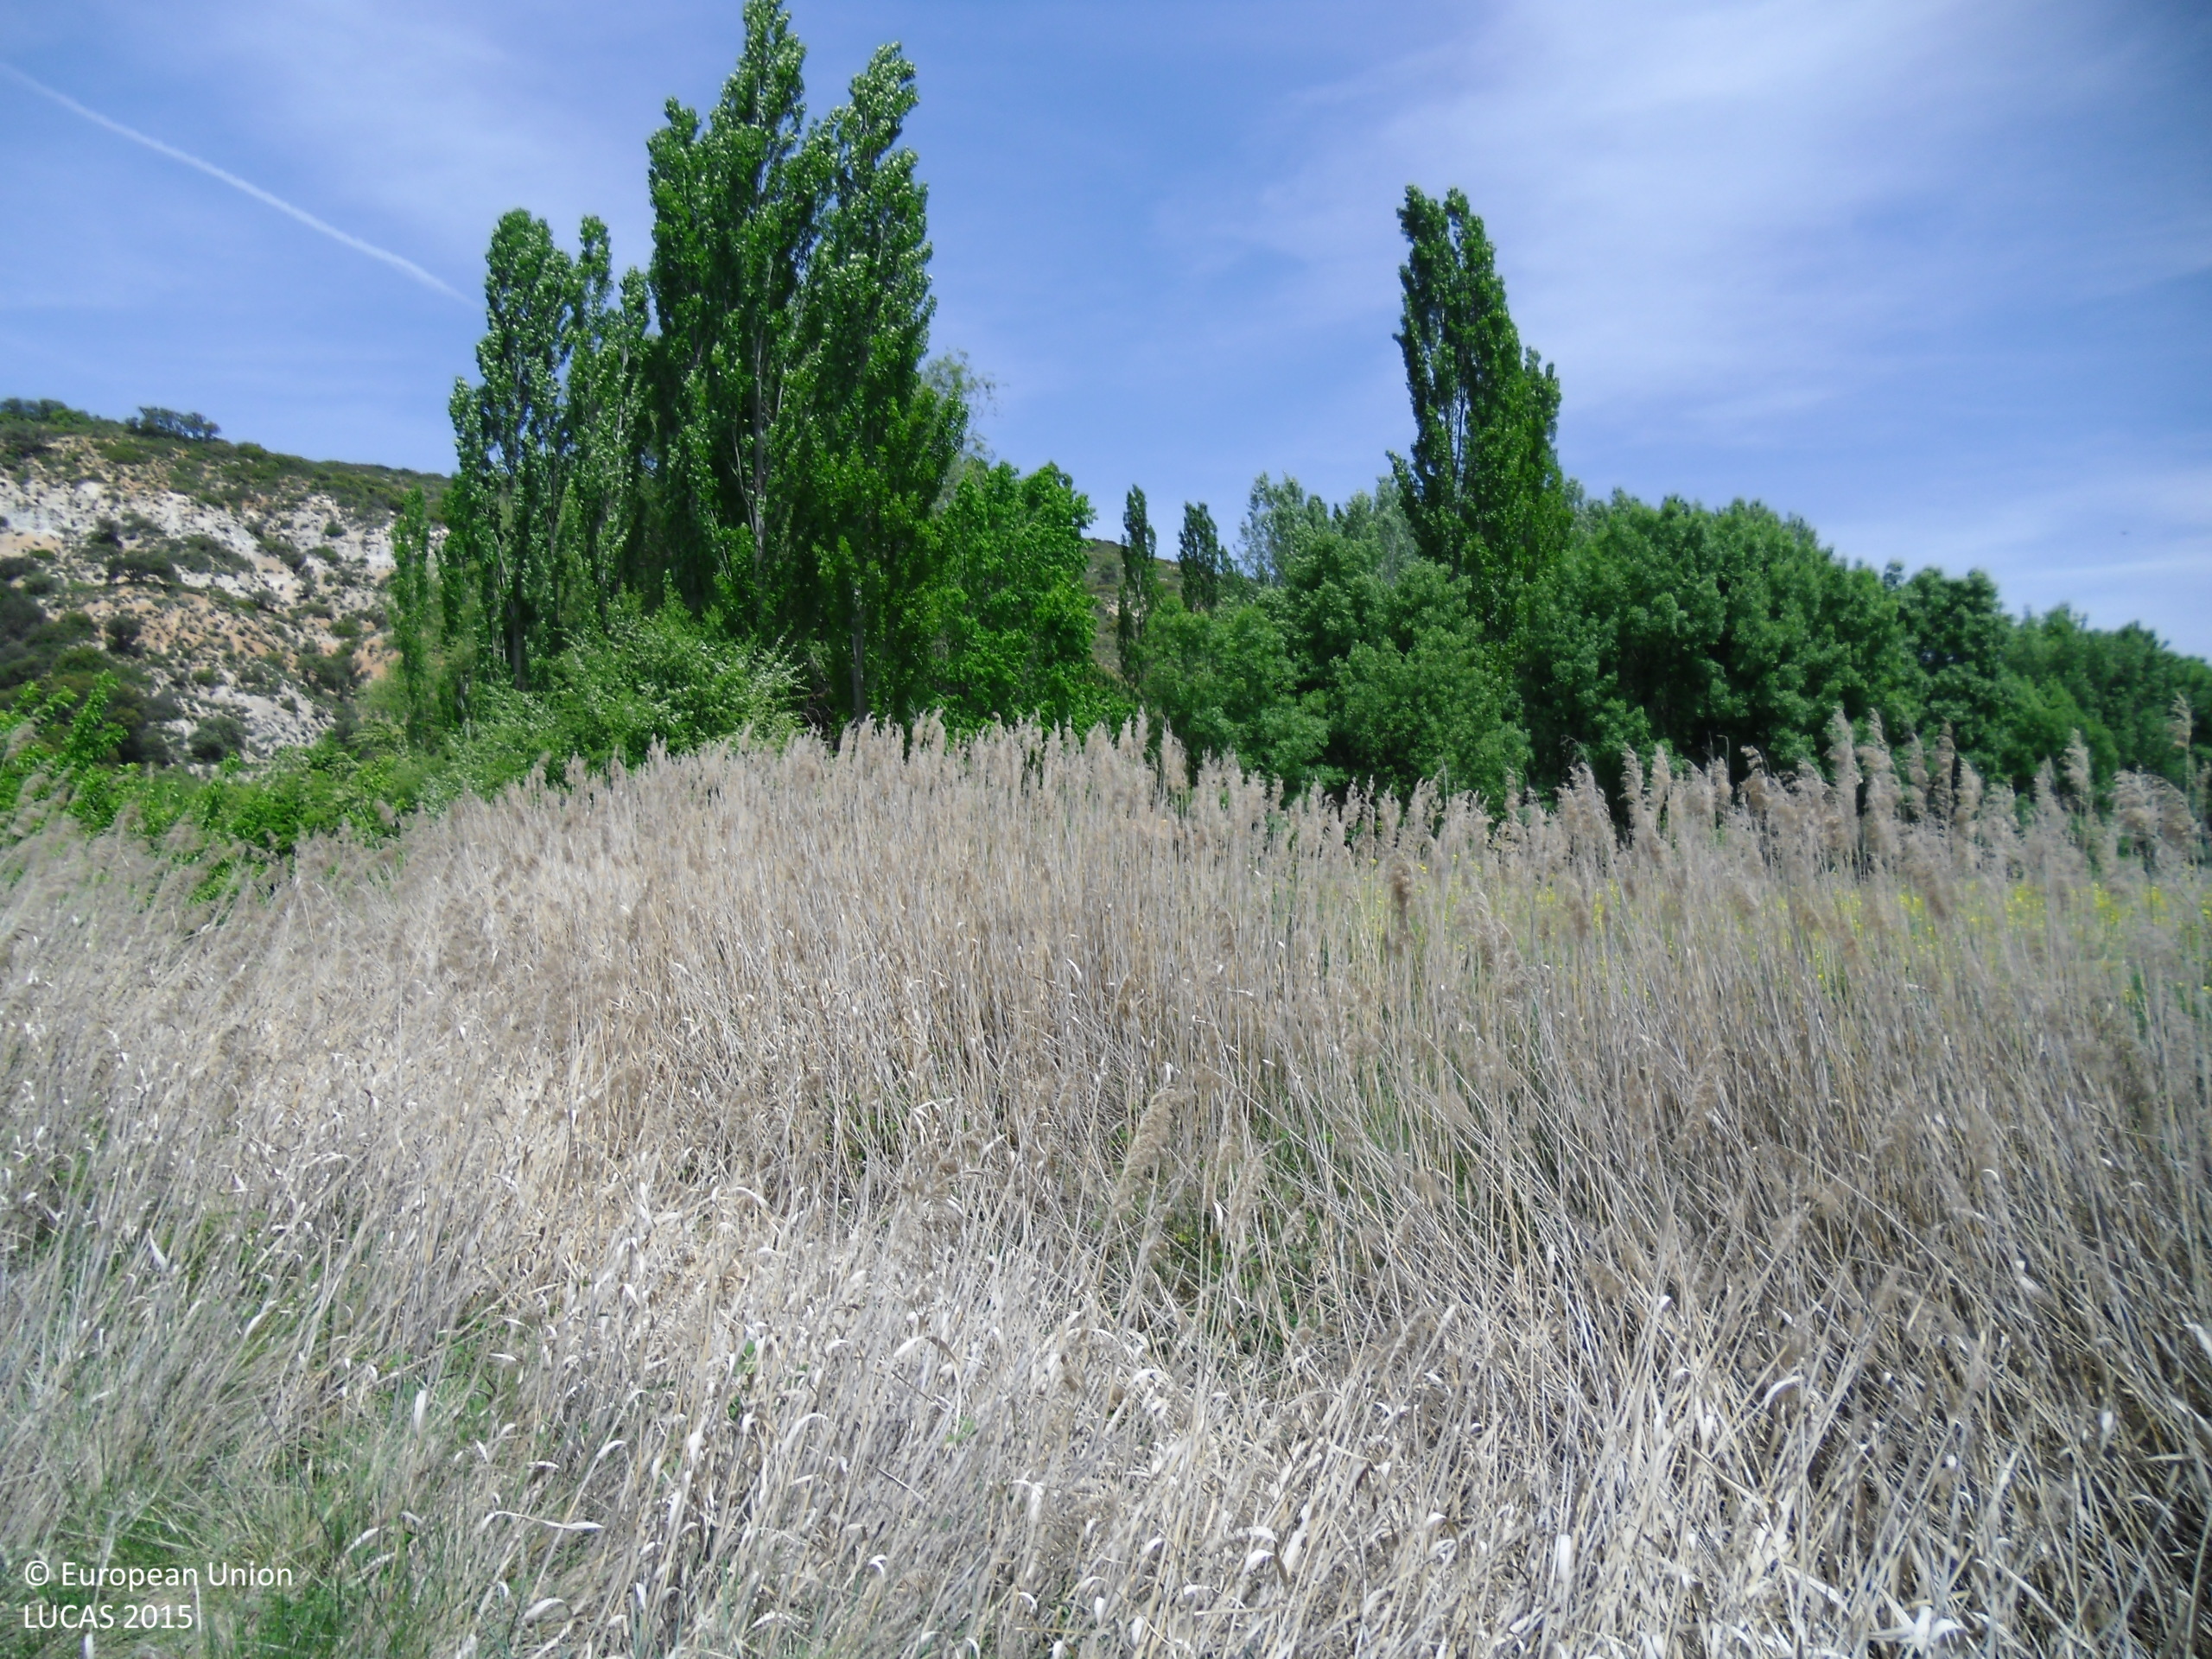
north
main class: Grassland
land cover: Grassland without tree/shrub cover
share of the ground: > 75 %
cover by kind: herbaceous plants 100 %
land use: Semi-natural and natural areas not in use
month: May
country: ES
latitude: 40.4965
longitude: -2.9970
